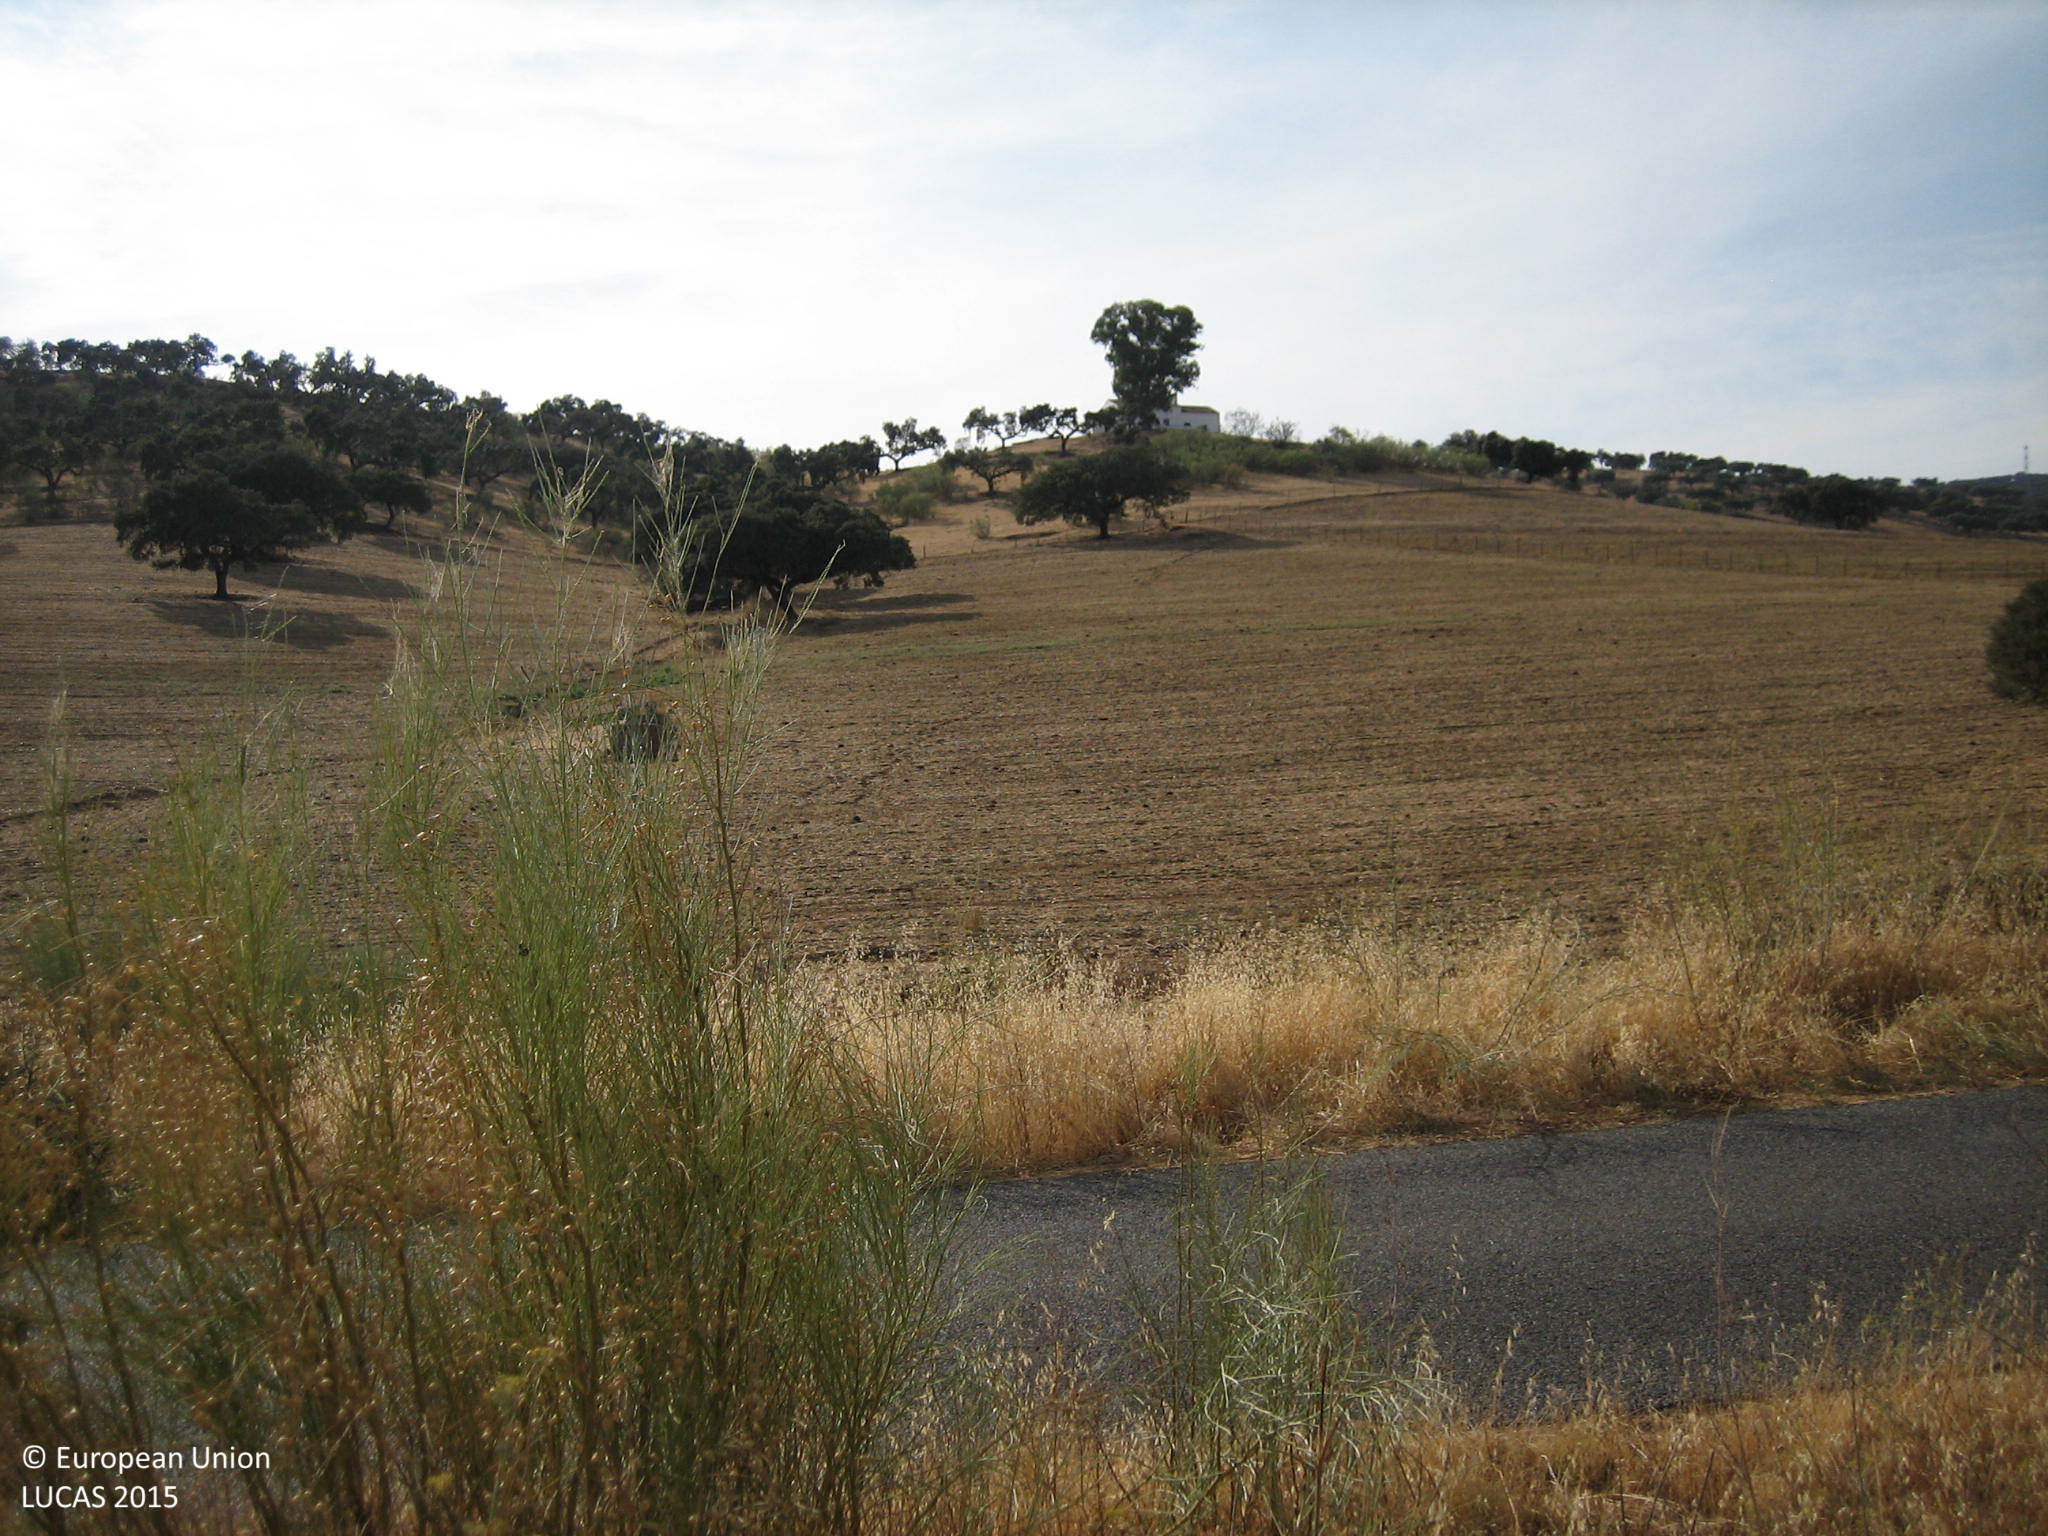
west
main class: Woodland
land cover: Broadleaved woodland
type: broadleaved evergreen forest
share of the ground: 10 - 25 %
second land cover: Grassland without tree/shrub cover
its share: > 75 %
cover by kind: herbaceous plants 90 %, broadleaved forest trees 10 %
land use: Forestry
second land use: Agriculture (excluding fallow land and kitchen gardens)
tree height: > 5 m
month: September
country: ES
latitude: 38.2720
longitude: -6.8006
